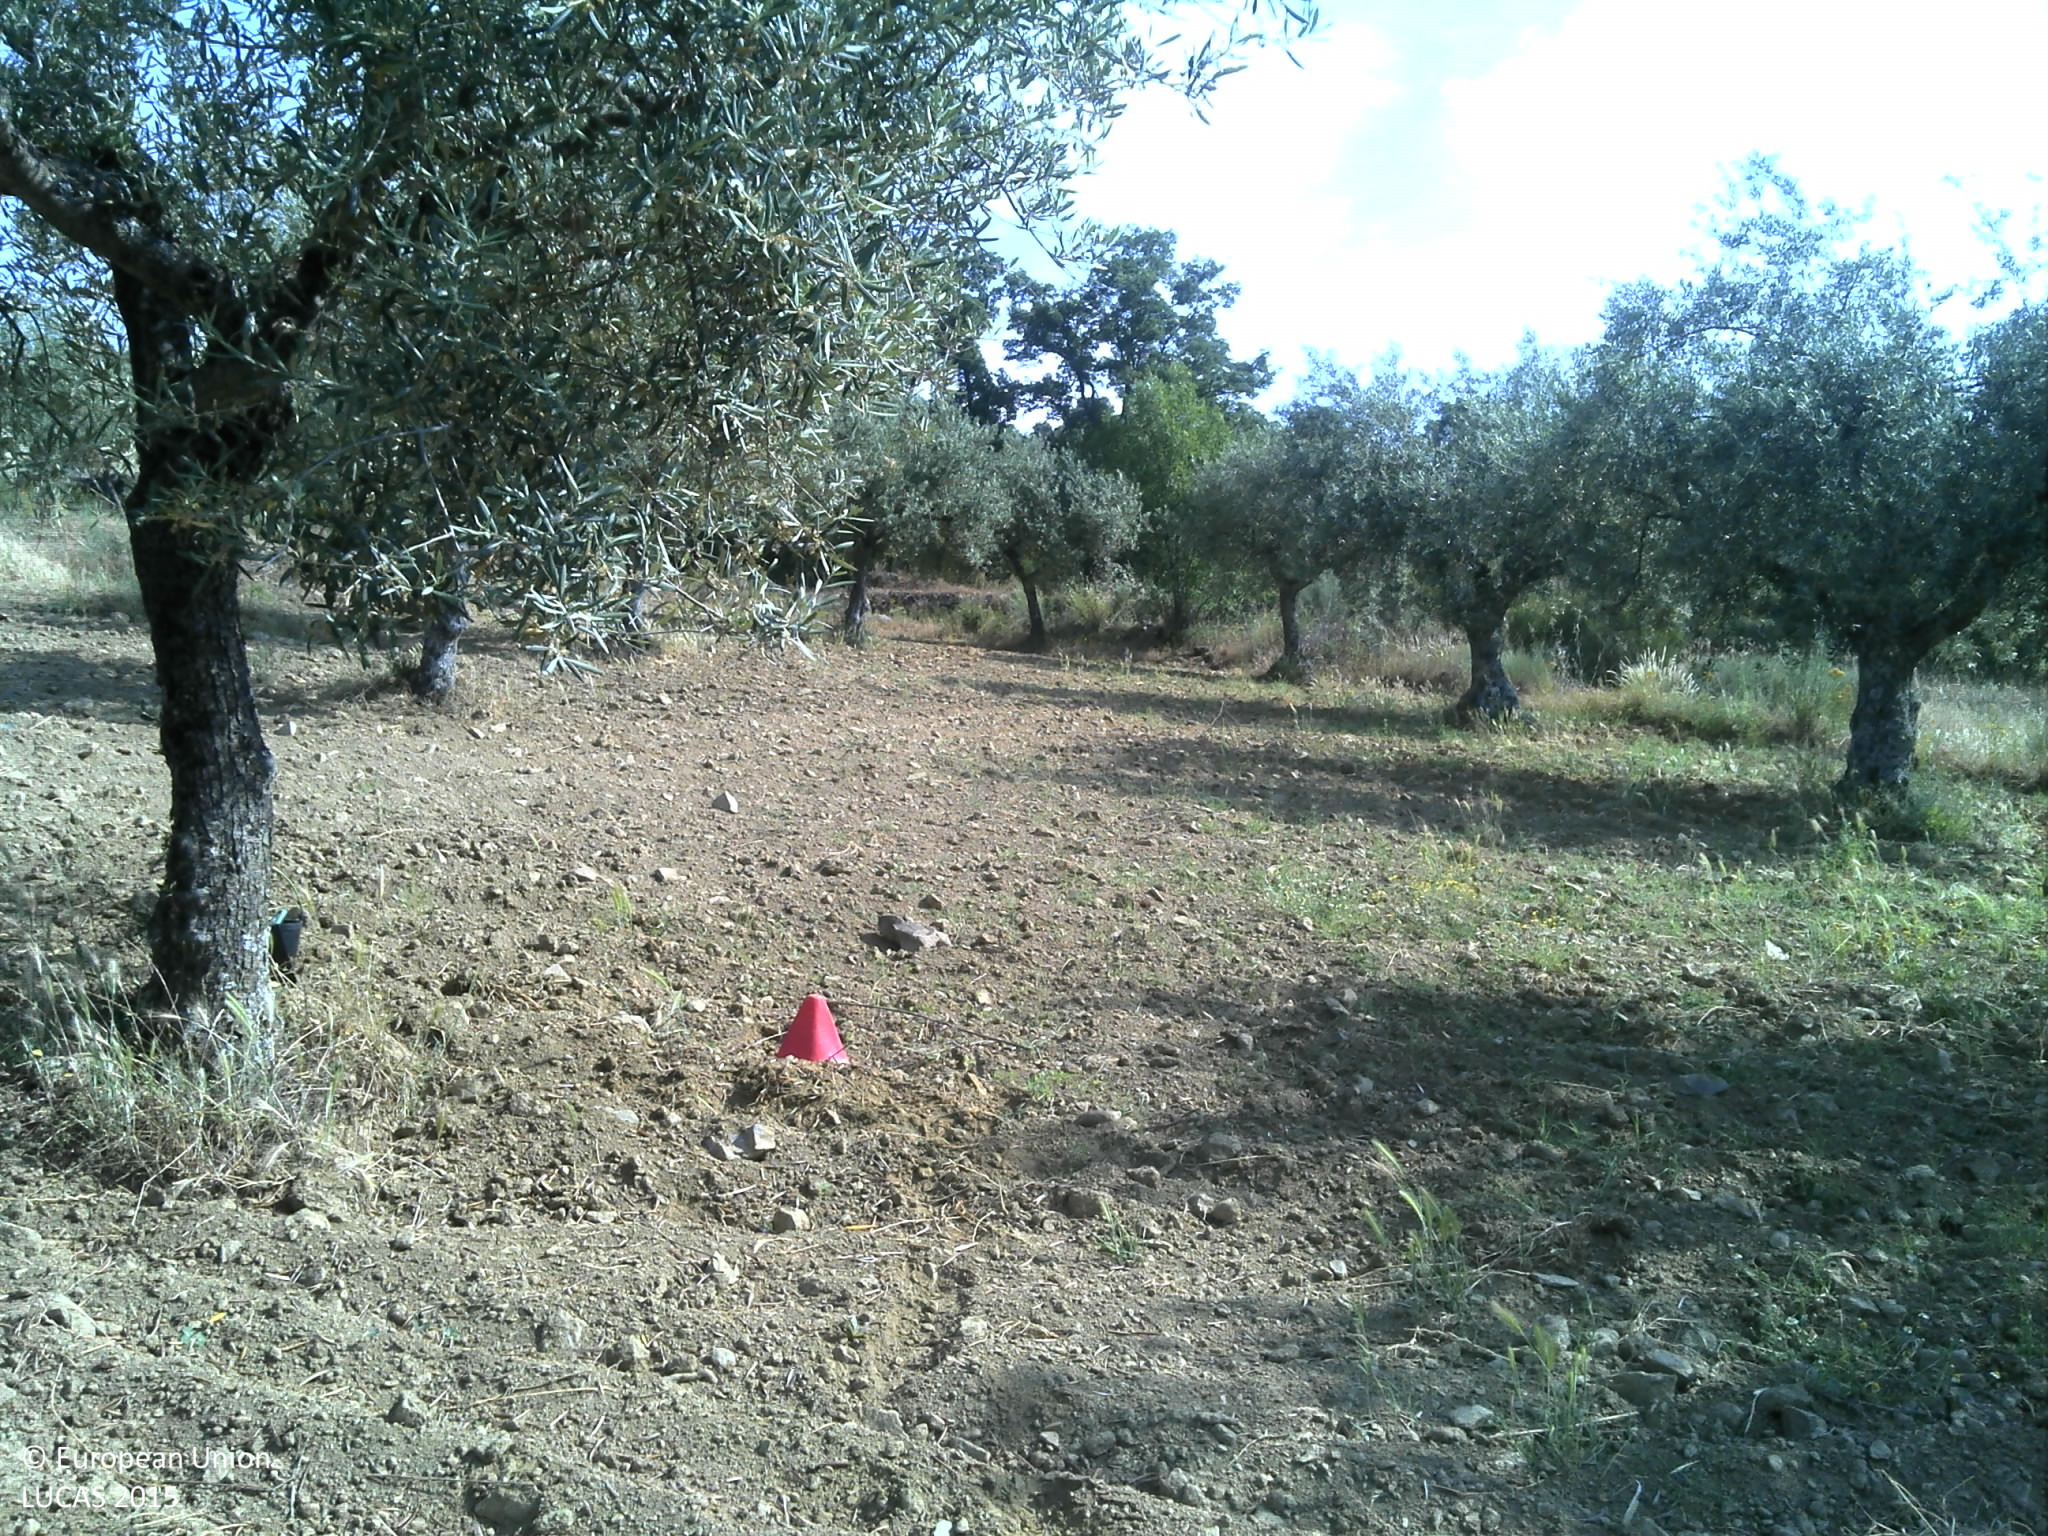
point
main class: Cropland
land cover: Olive groves
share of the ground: 10 - 25 %
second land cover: Spontaneously vegetated surfaces
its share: 10 - 25 %
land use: Agriculture (excluding fallow land and kitchen gardens)
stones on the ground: 10 - 25 %
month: June
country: PT
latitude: 41.5179
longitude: -6.9985
